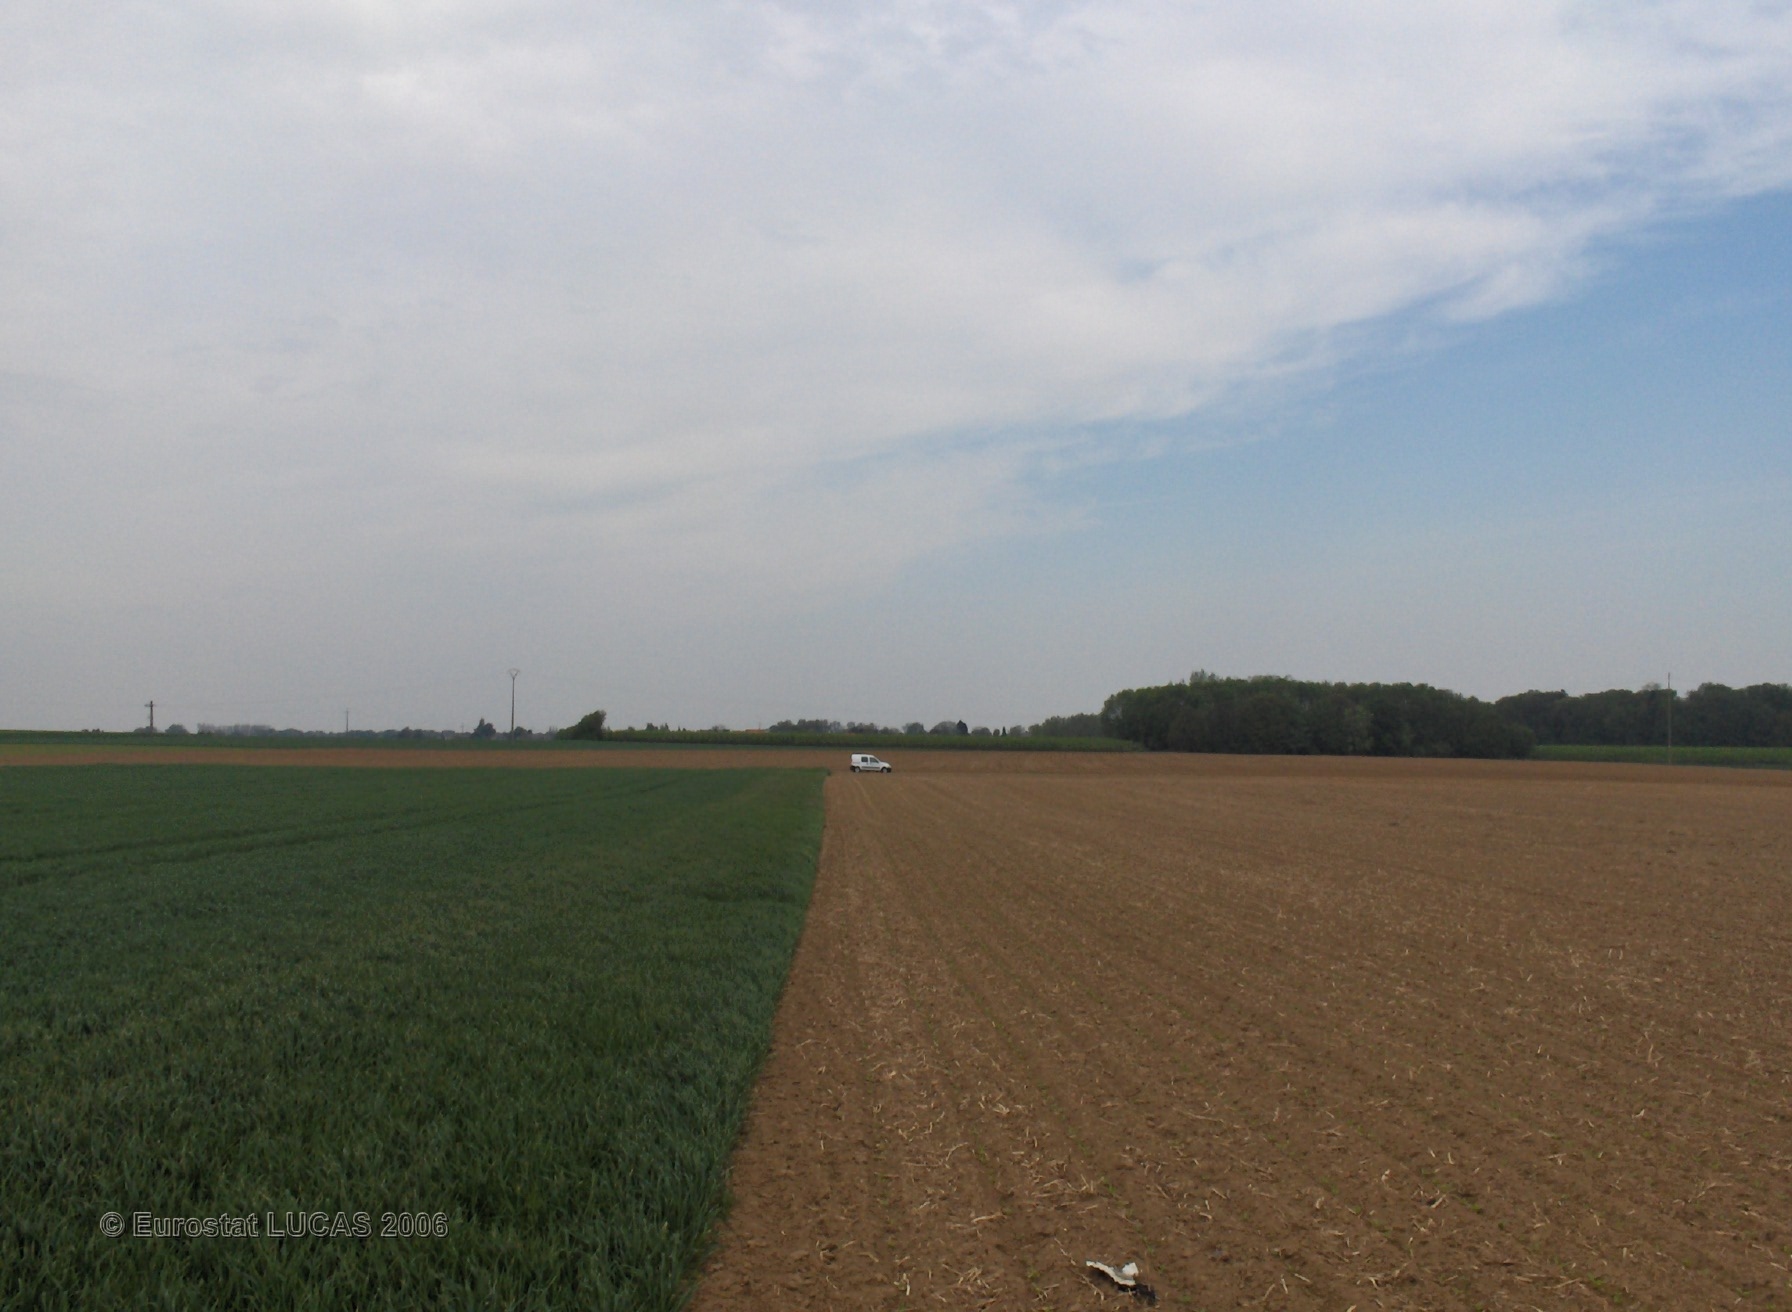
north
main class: Cropland
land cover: Sugar beet
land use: Agriculture (excluding fallow land and kitchen gardens)
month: May
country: BE
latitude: 50.6250
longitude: 5.2339
